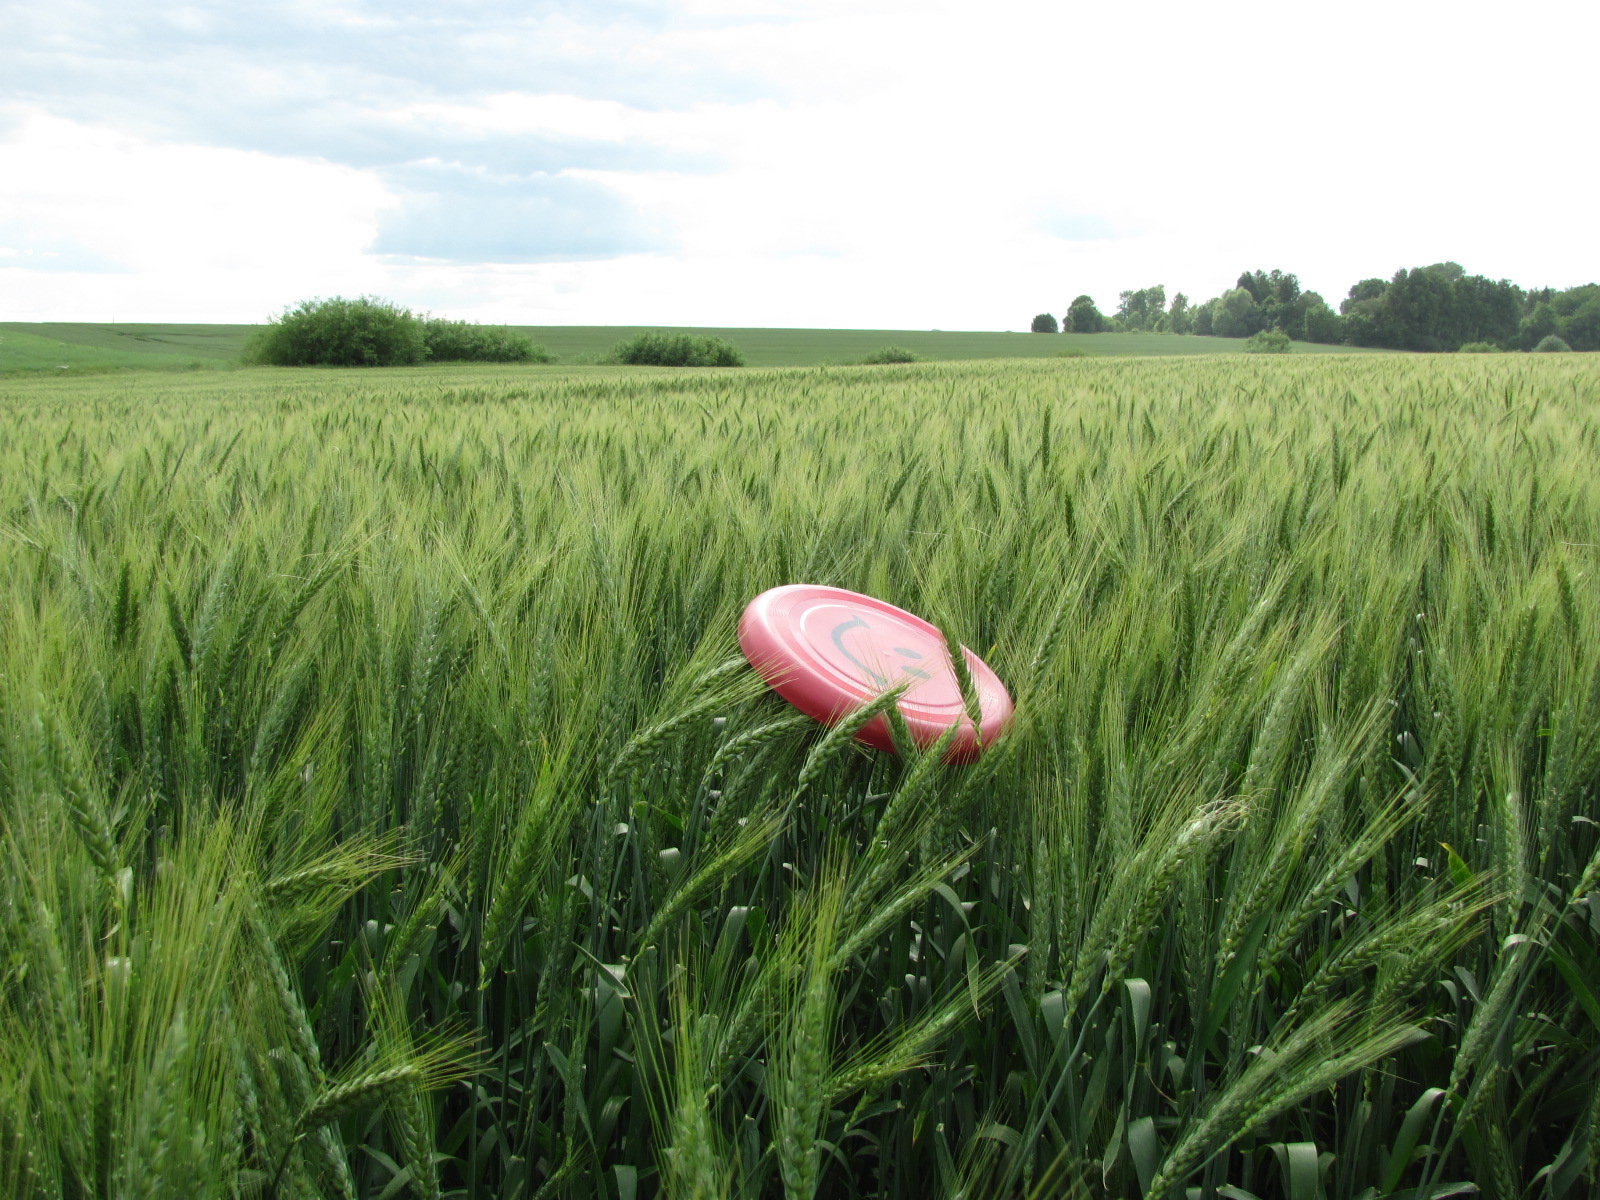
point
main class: Cropland
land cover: Triticale
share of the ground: > 75 %
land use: Agriculture (excluding fallow land and kitchen gardens)
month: June
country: LV
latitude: 56.5108
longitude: 24.0115
